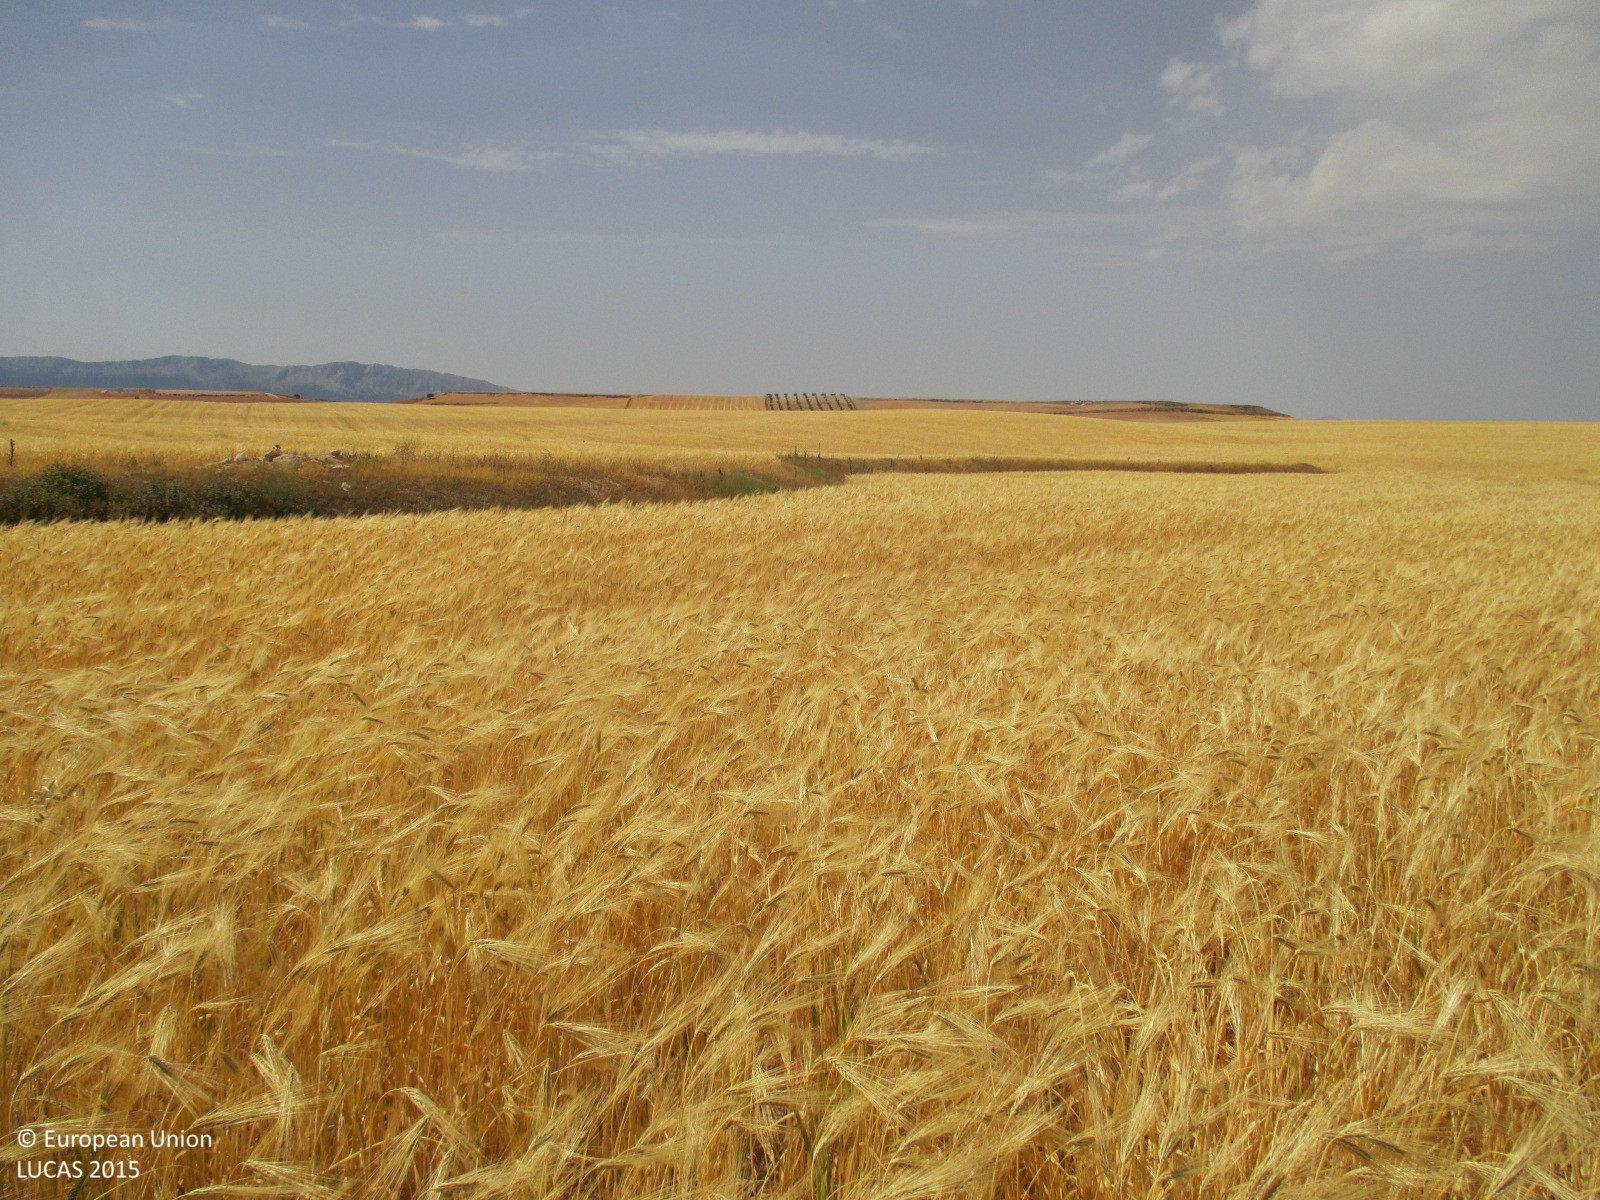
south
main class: Cropland
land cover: Barley
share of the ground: > 75 %
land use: Agriculture (excluding fallow land and kitchen gardens)
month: July
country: ES
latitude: 37.7932
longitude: -2.2637
